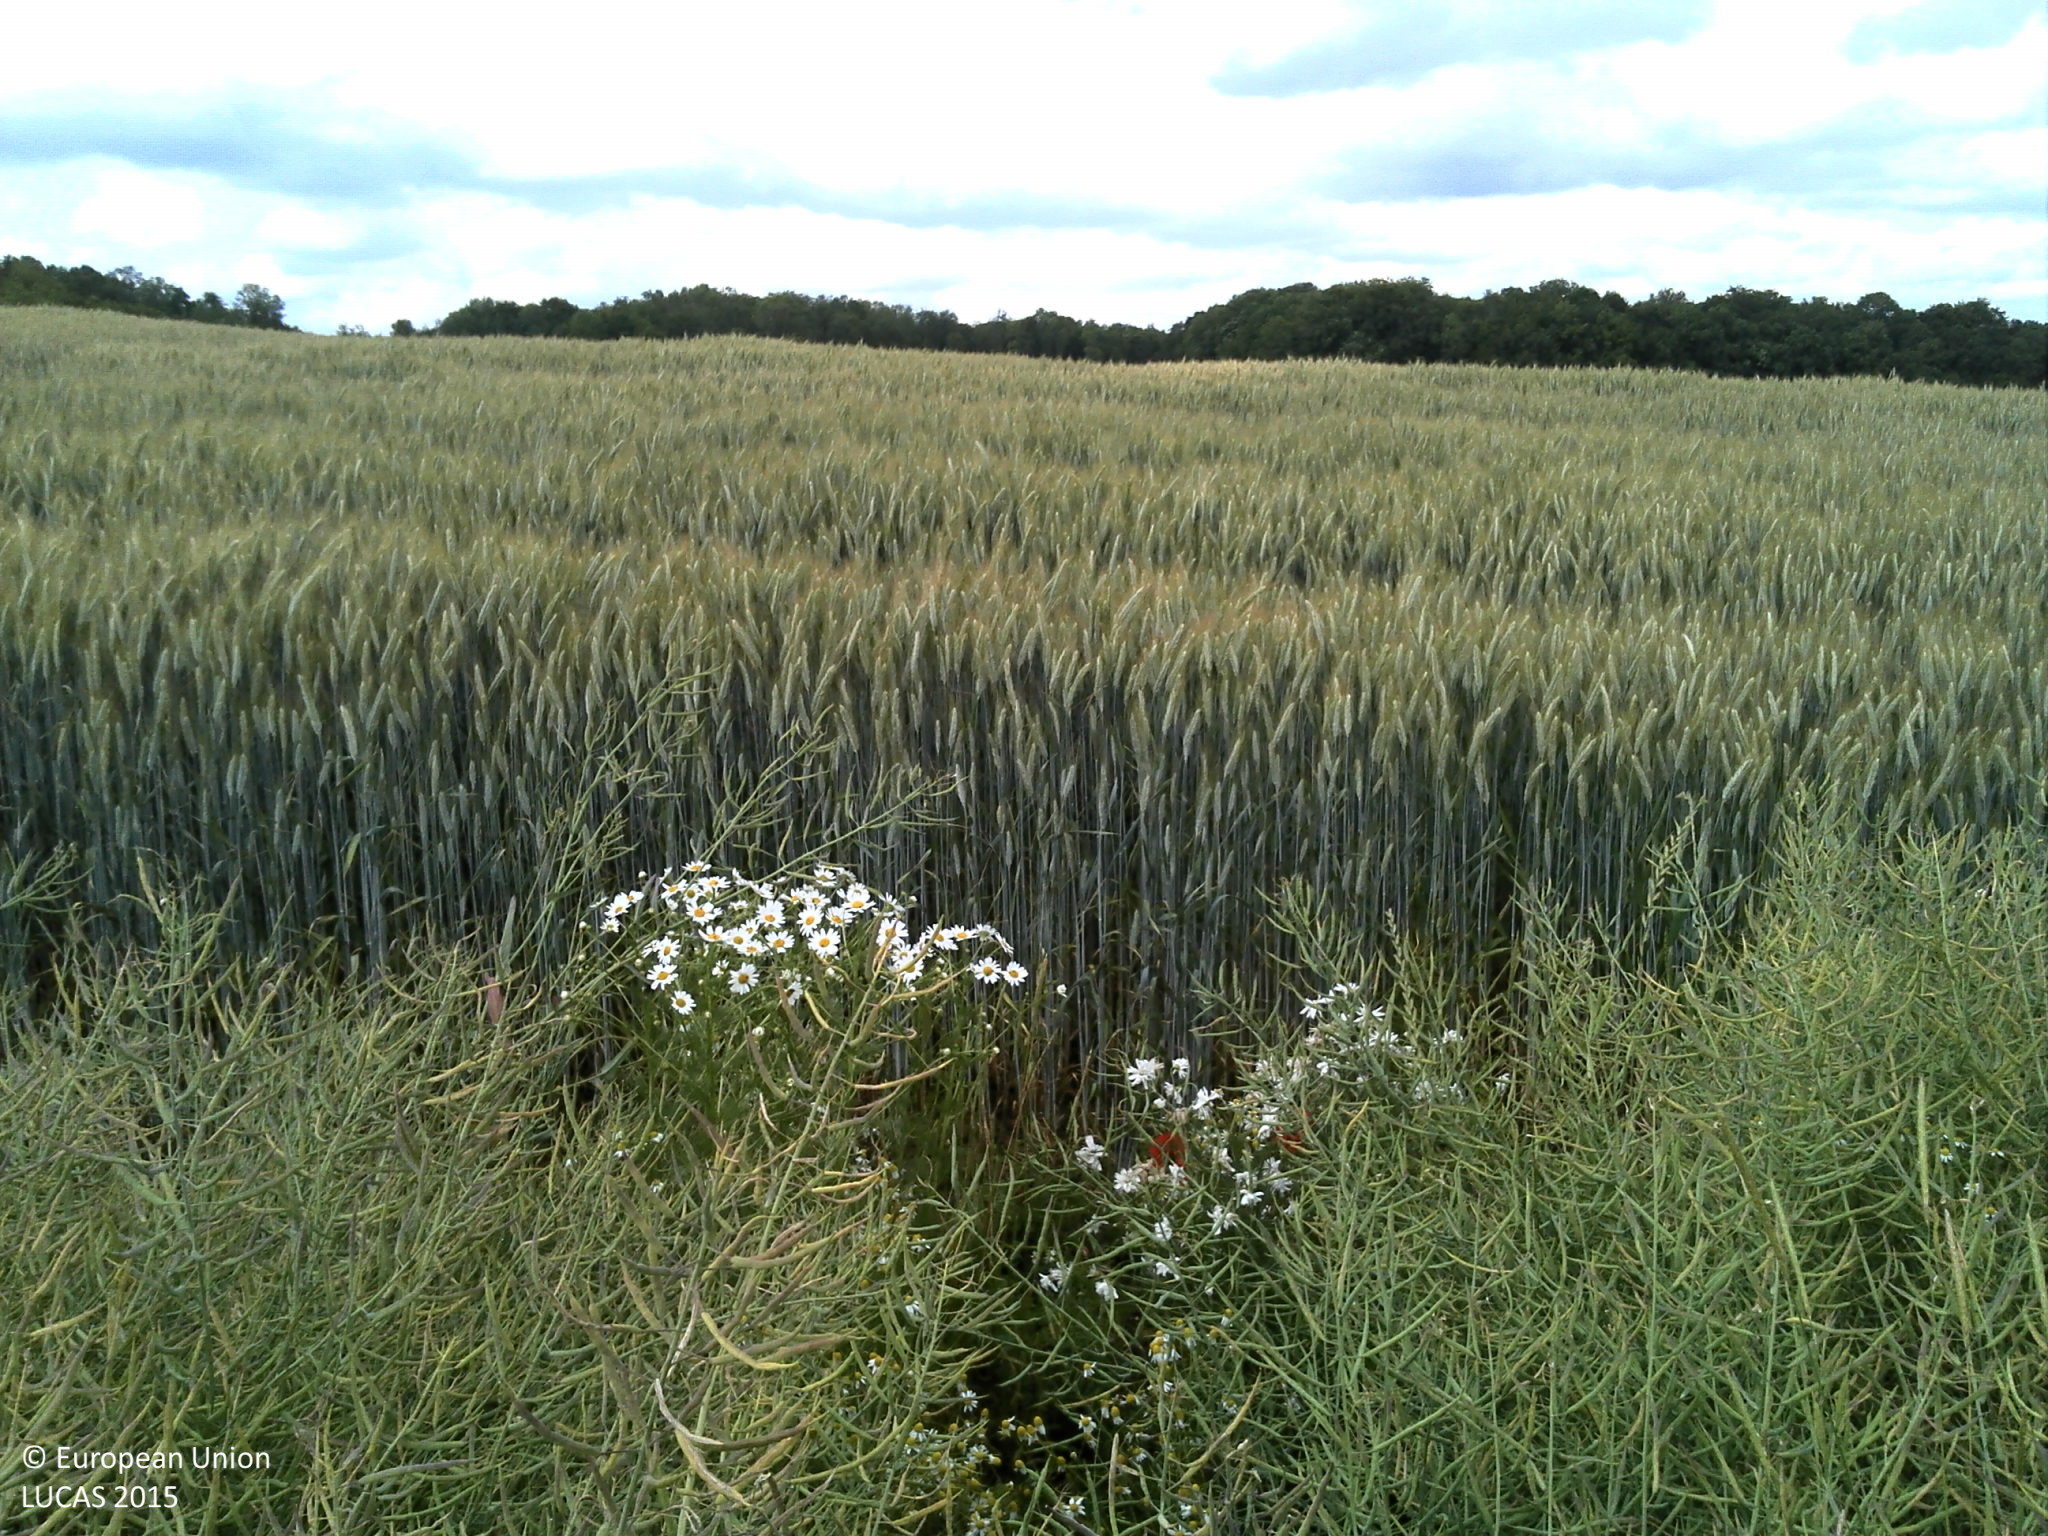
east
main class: Cropland
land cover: Rape and turnip rape
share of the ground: > 75 %
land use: Agriculture (excluding fallow land and kitchen gardens)
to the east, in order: Rape and turnip rape; Common wheat; Rape and turnip rape
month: June
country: FR
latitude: 49.4448
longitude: 5.0185
